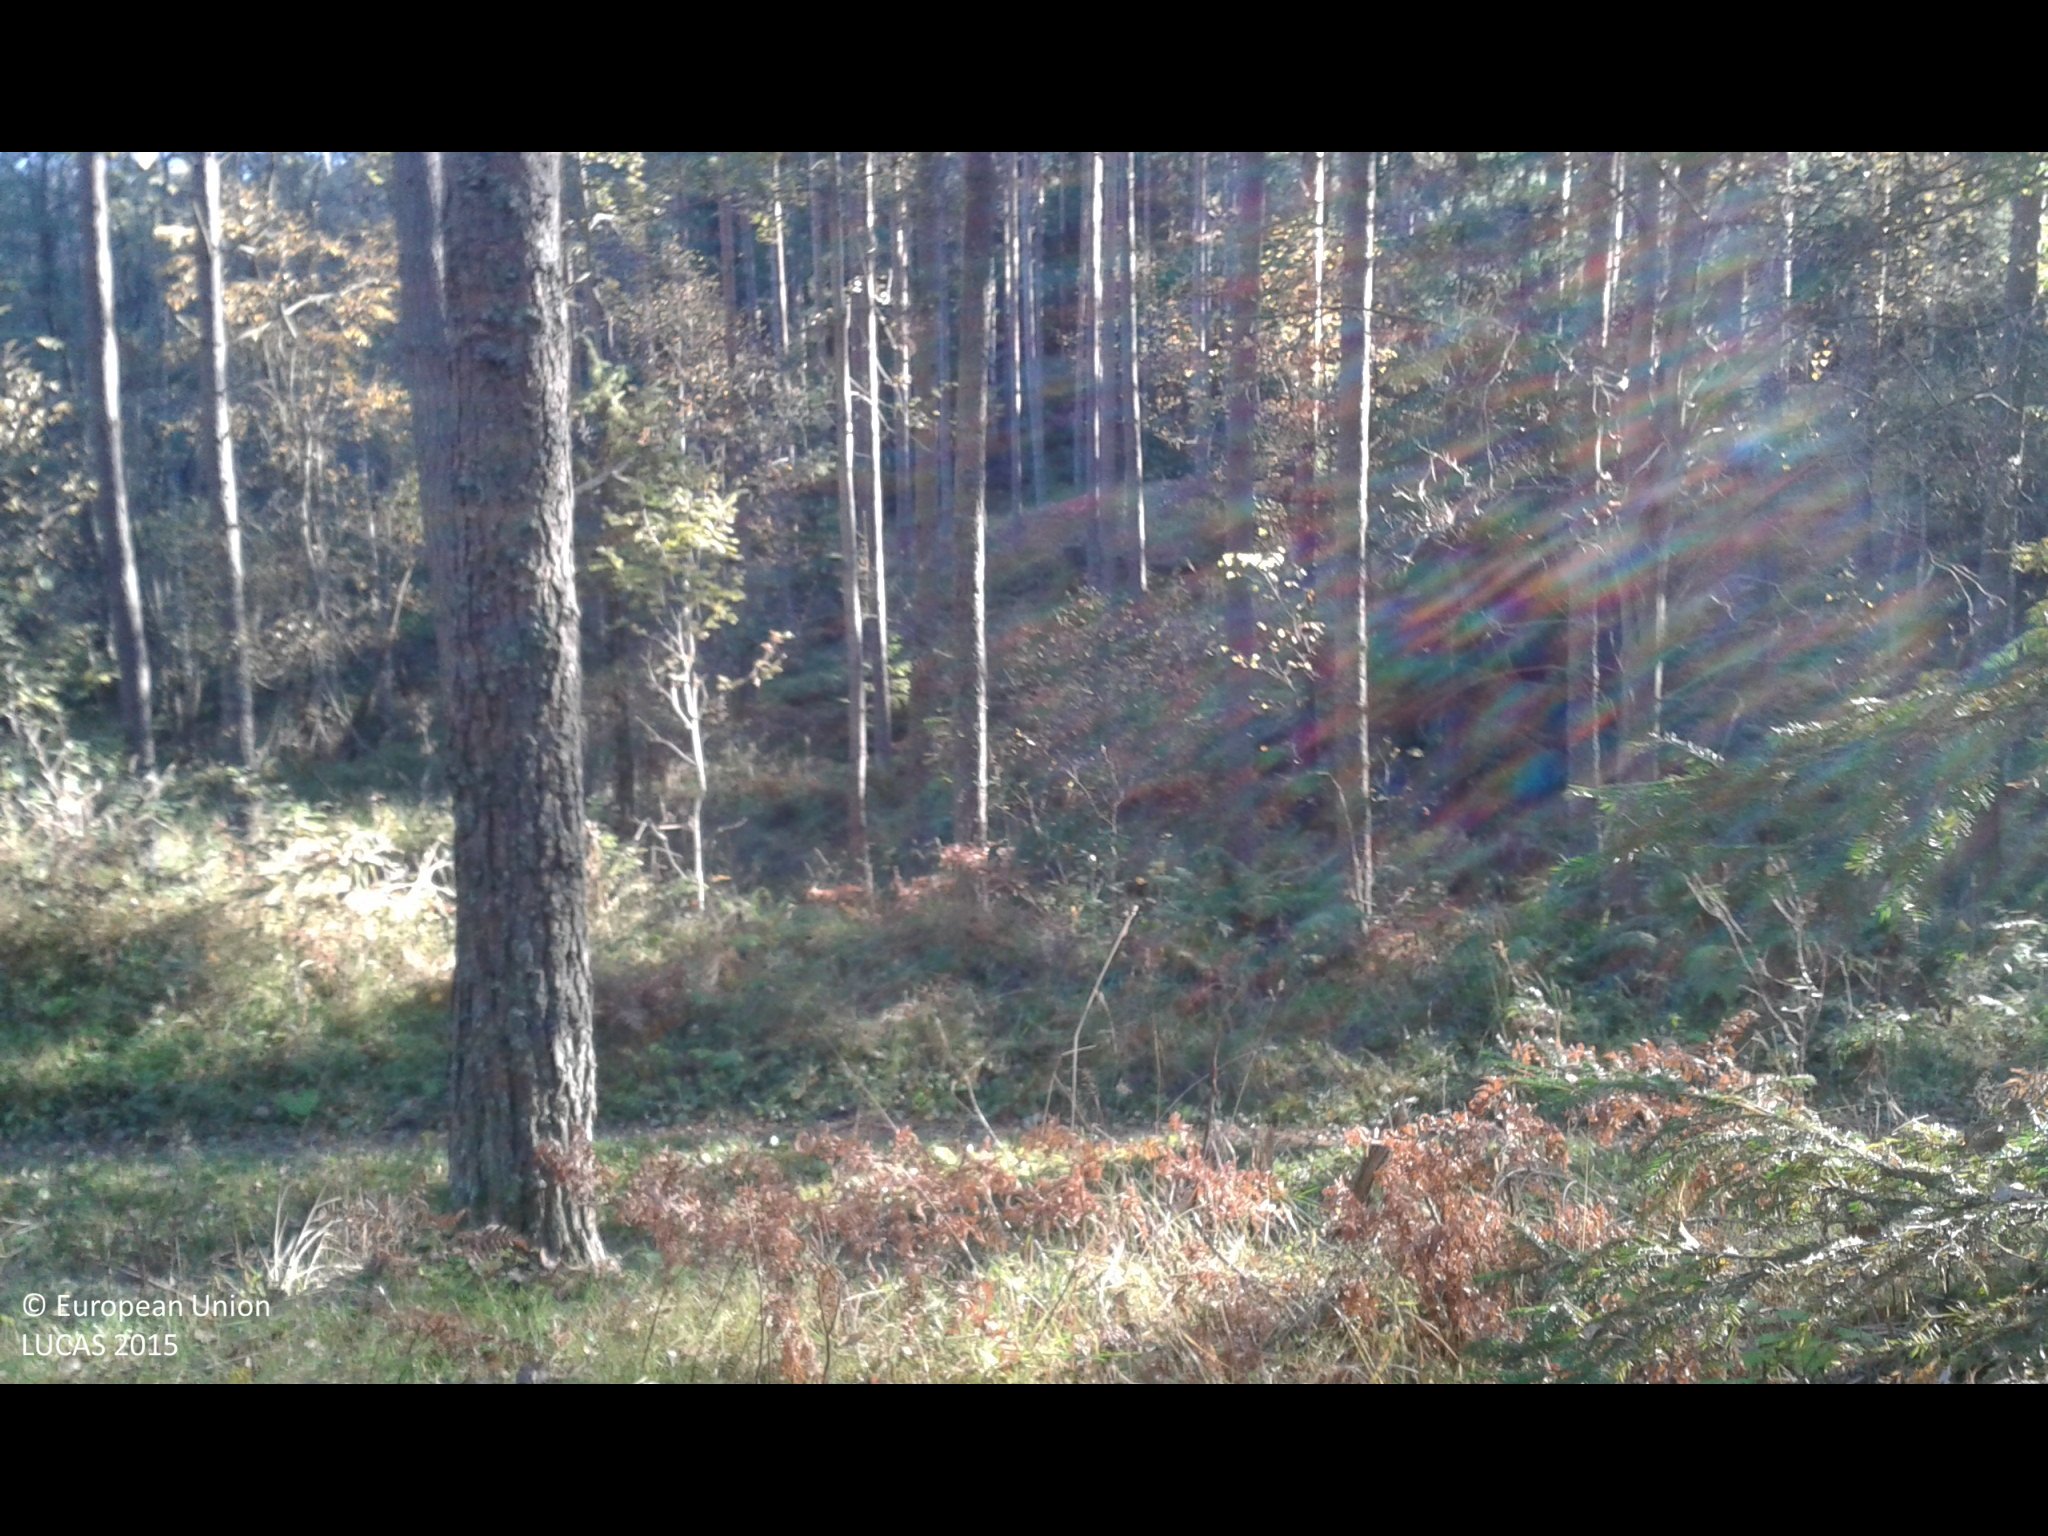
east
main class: Woodland
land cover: Pine dominated coniferous woodland
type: boreal forest
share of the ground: 50 - 75 %
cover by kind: coniferous forest trees 55 %, herbaceous plants 30 %, broadleaved forest trees 15 %
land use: Forestry
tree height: > 5 m
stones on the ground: < 10 %
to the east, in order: Pine dominated coniferous woodland; Tracks; Pine dominated coniferous woodland; Pine dominated mixed woodland; Pine dominated coniferous woodland
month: October
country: SE
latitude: 58.8866
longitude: 17.3366
